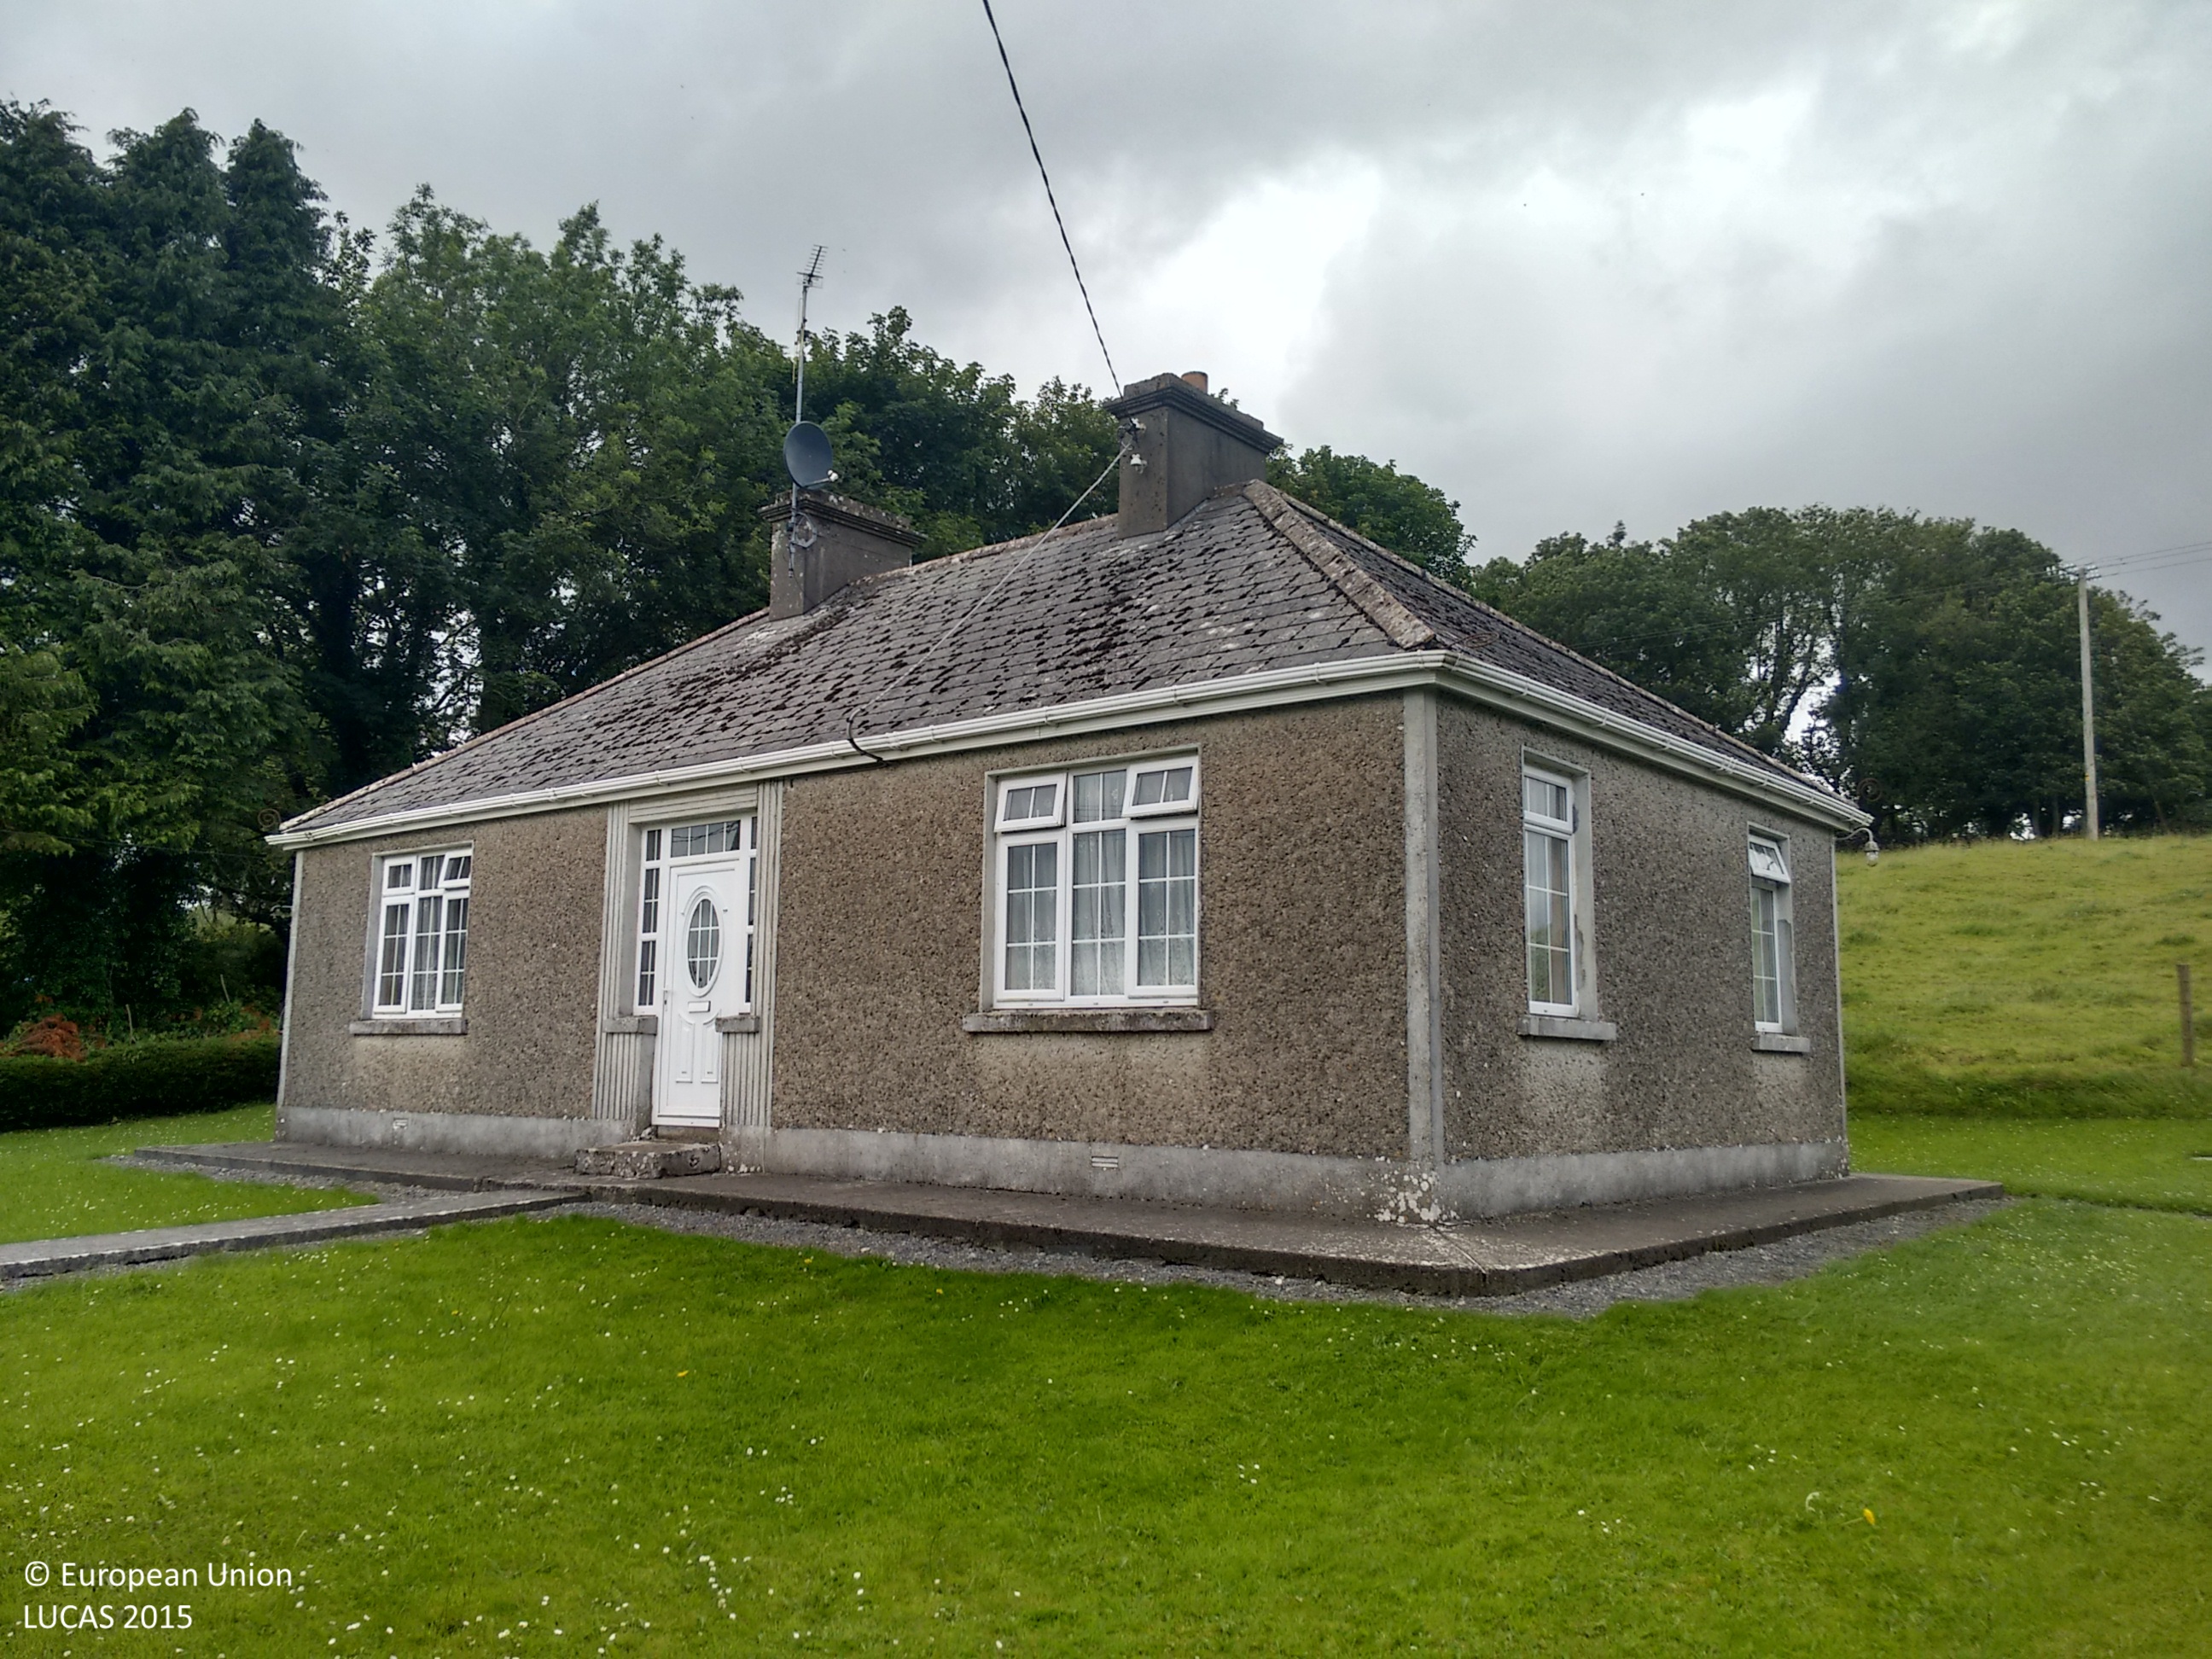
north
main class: Grassland
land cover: Grassland without tree/shrub cover
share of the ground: > 75 %
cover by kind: herbaceous plants 100 %
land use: Agriculture (excluding fallow land and kitchen gardens)
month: July
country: IE
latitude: 53.6567
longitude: -8.8638
